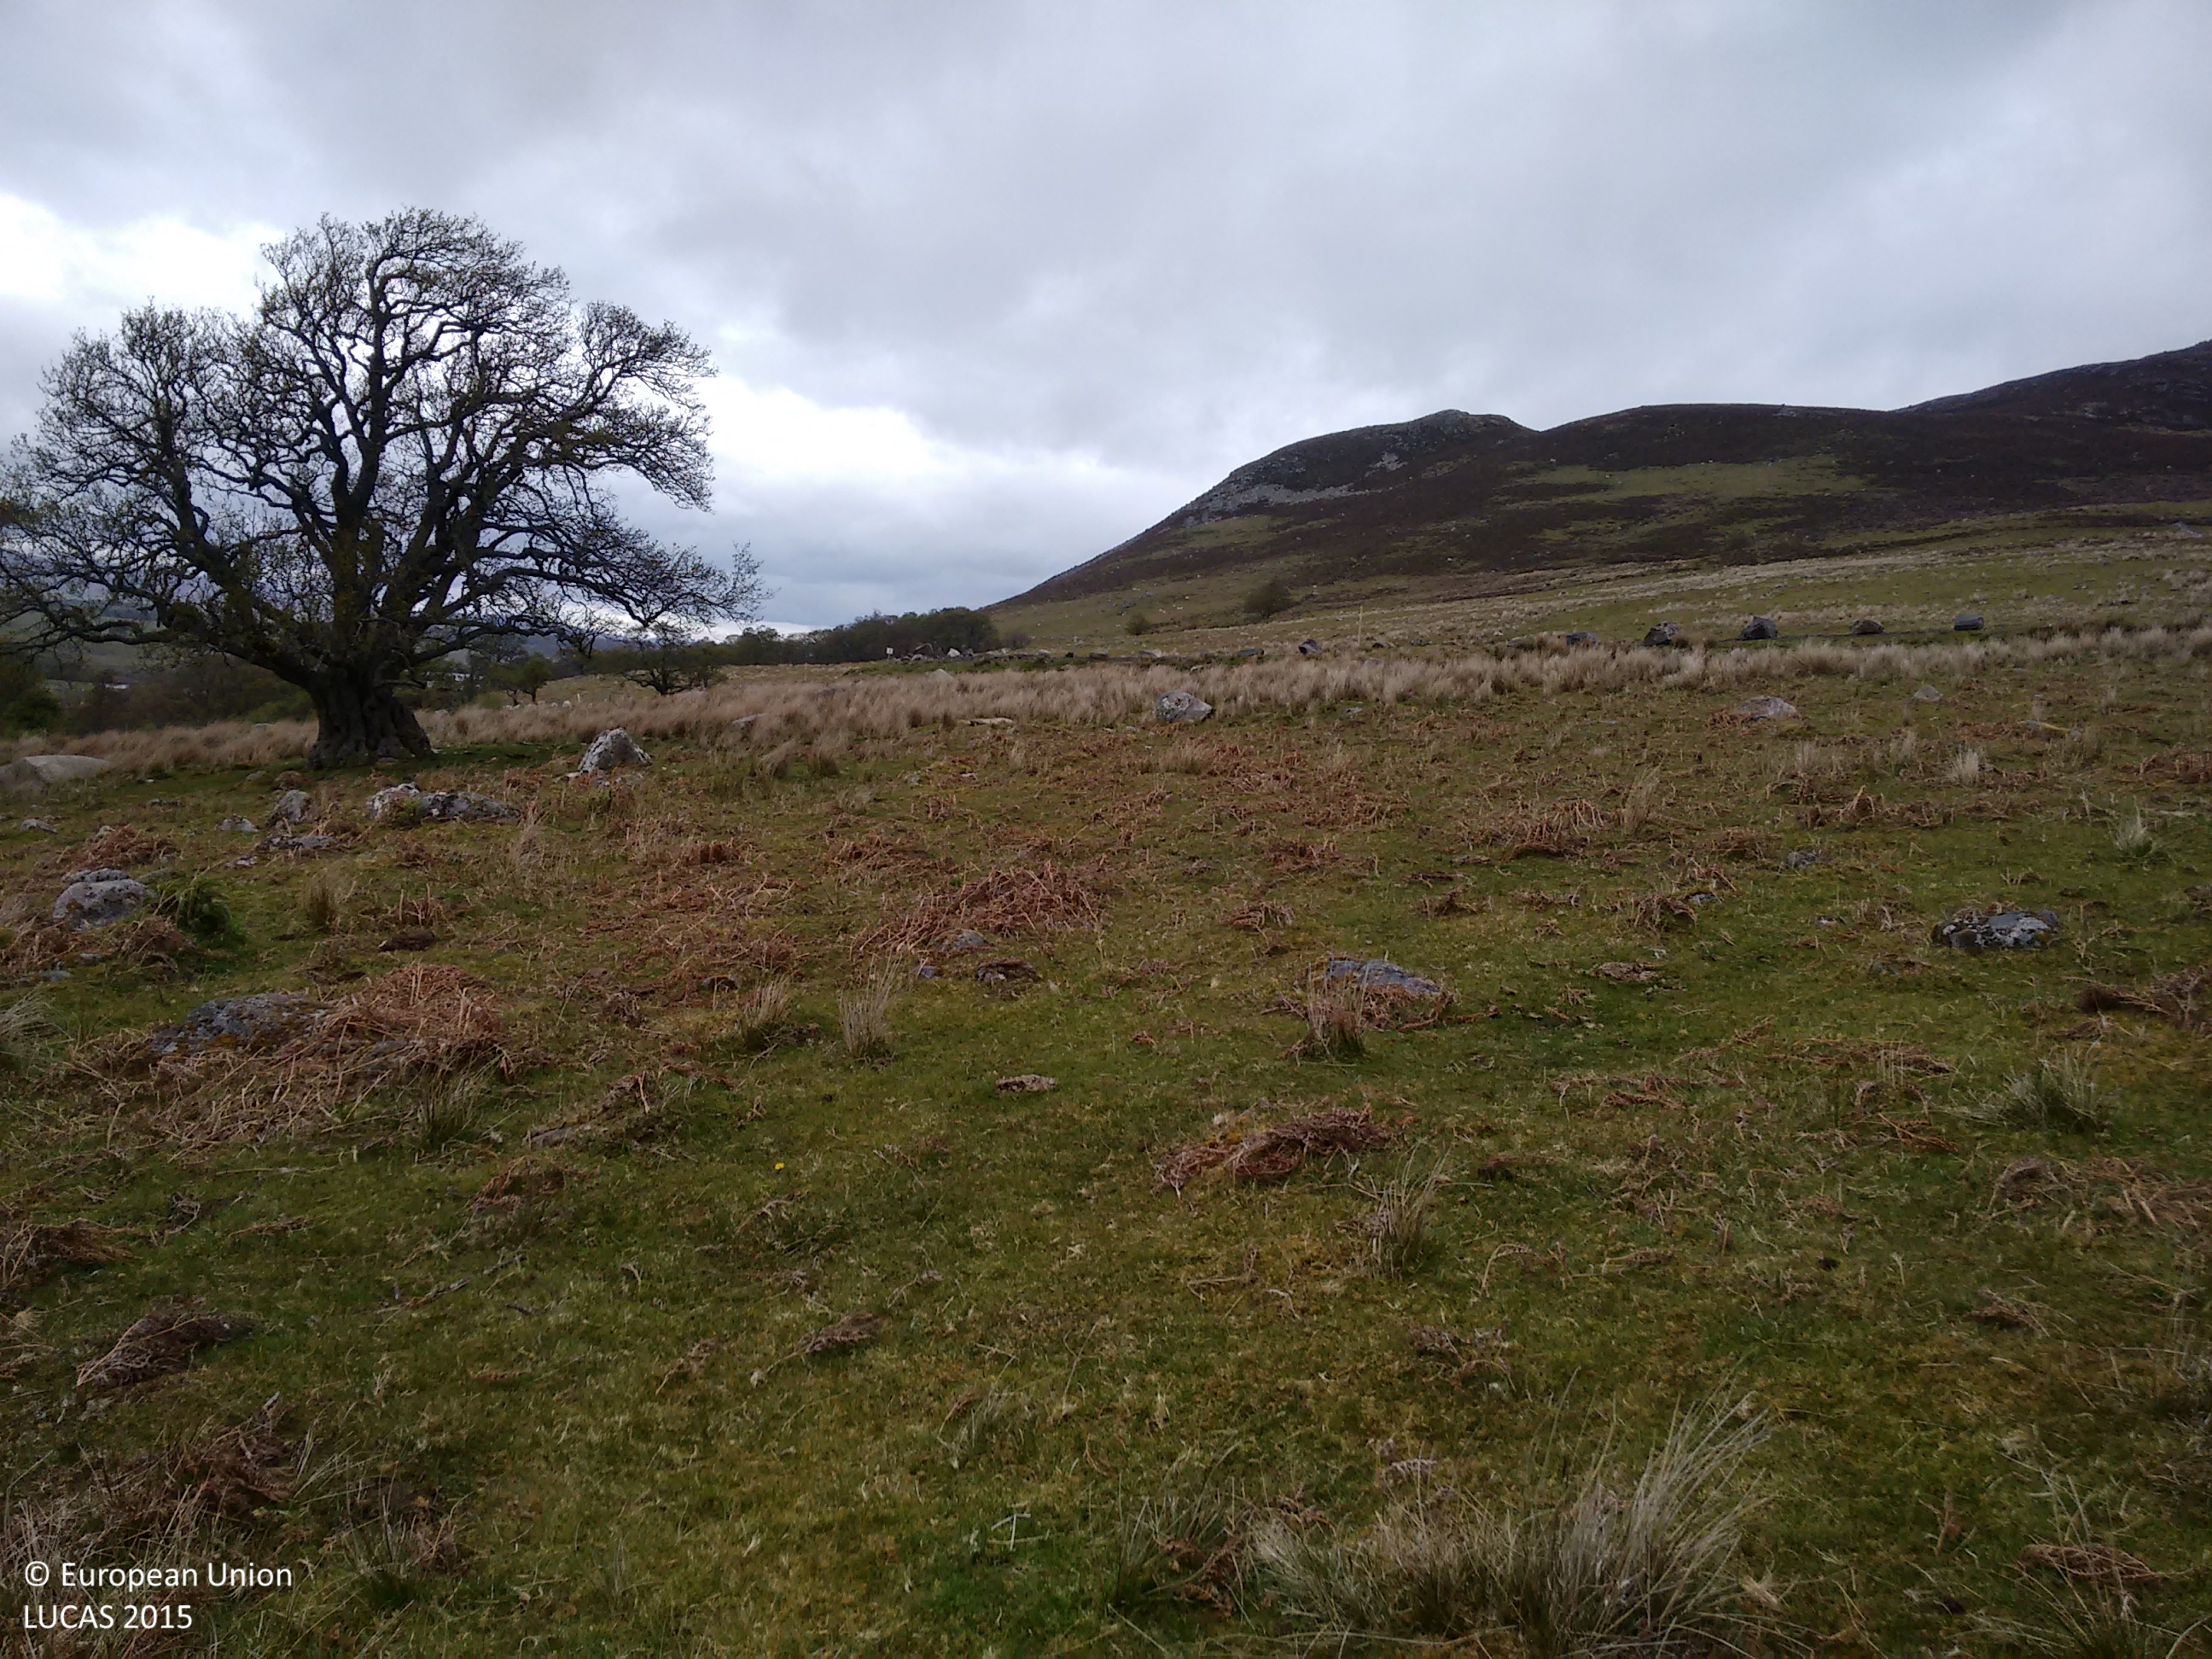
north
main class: Grassland
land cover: Grassland with sparse tree/shrub cover
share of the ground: > 75 %
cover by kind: herbaceous plants 95 %, broadleaved forest trees 5 %
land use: Agriculture (excluding fallow land and kitchen gardens)
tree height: > 5 m
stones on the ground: < 10 %
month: June
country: GB
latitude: 57.2132
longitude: -4.4467
